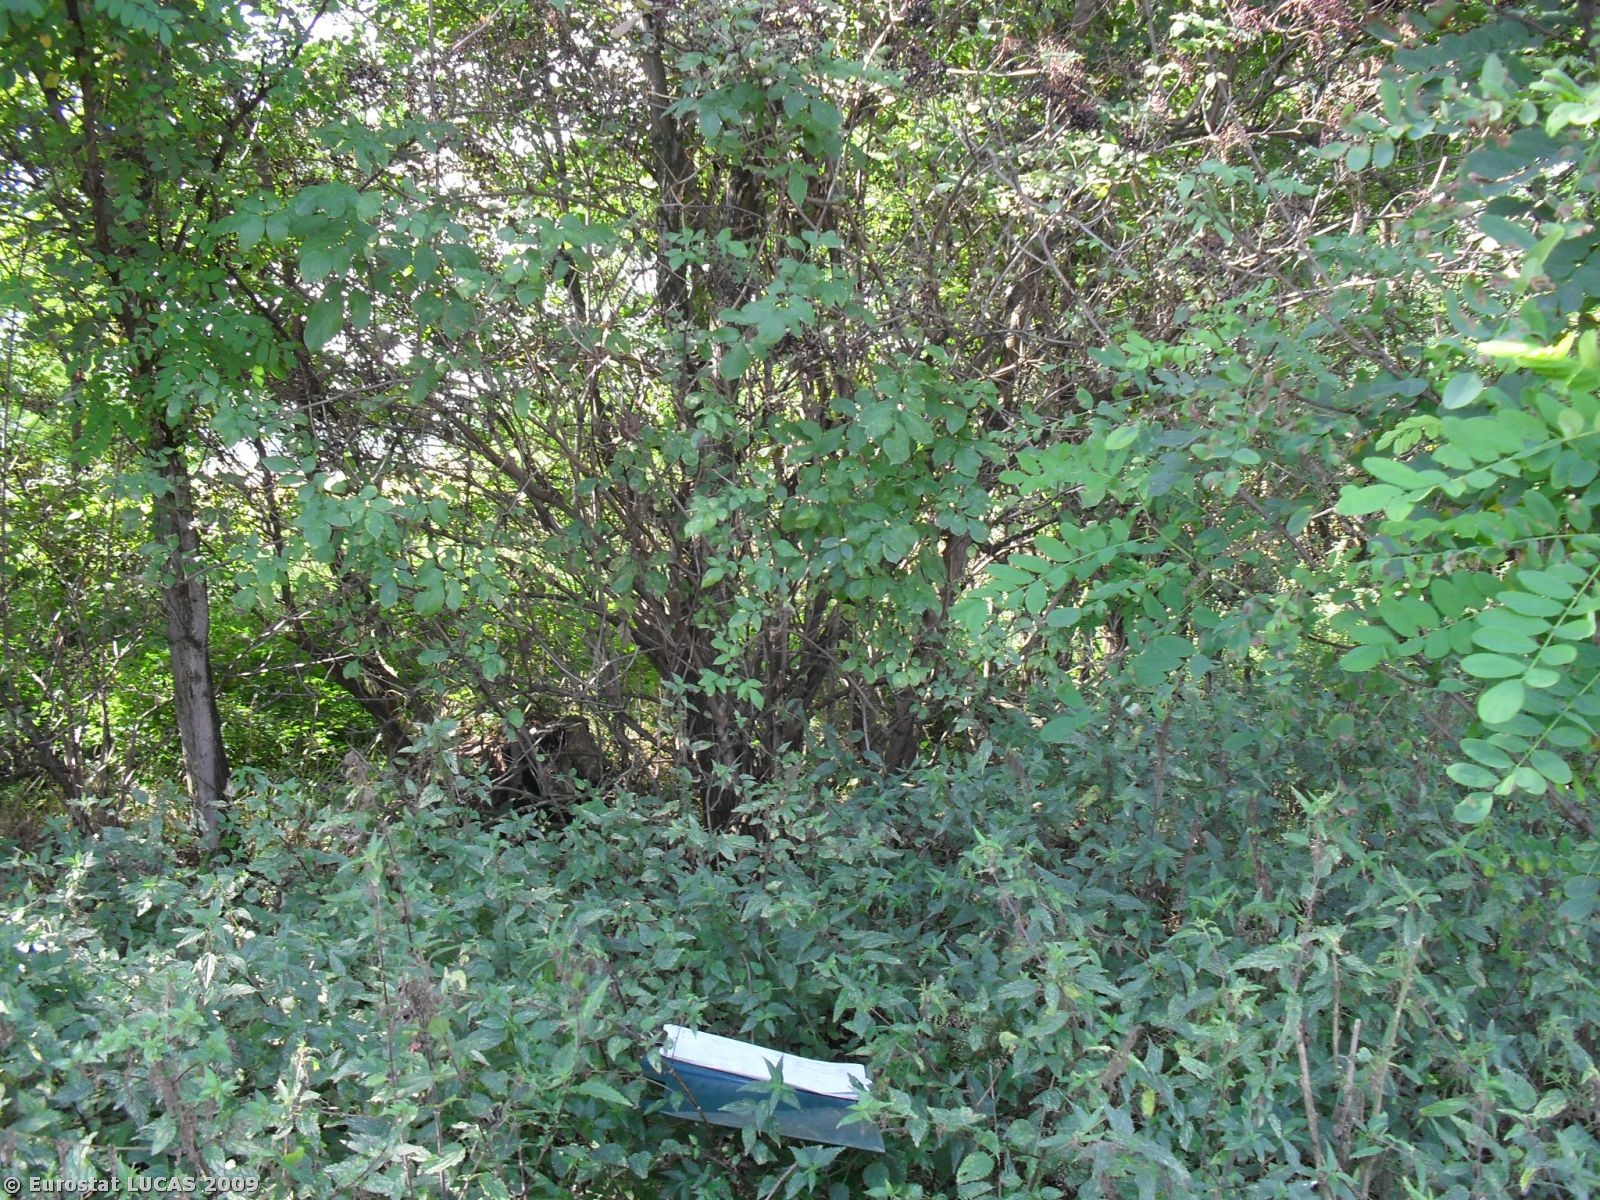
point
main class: Shrubland
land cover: Shrubland with sparse tree cover
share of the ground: > 75 %
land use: Unused
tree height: > 5 m
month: September
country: PL
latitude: 50.6384
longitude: 17.2651
